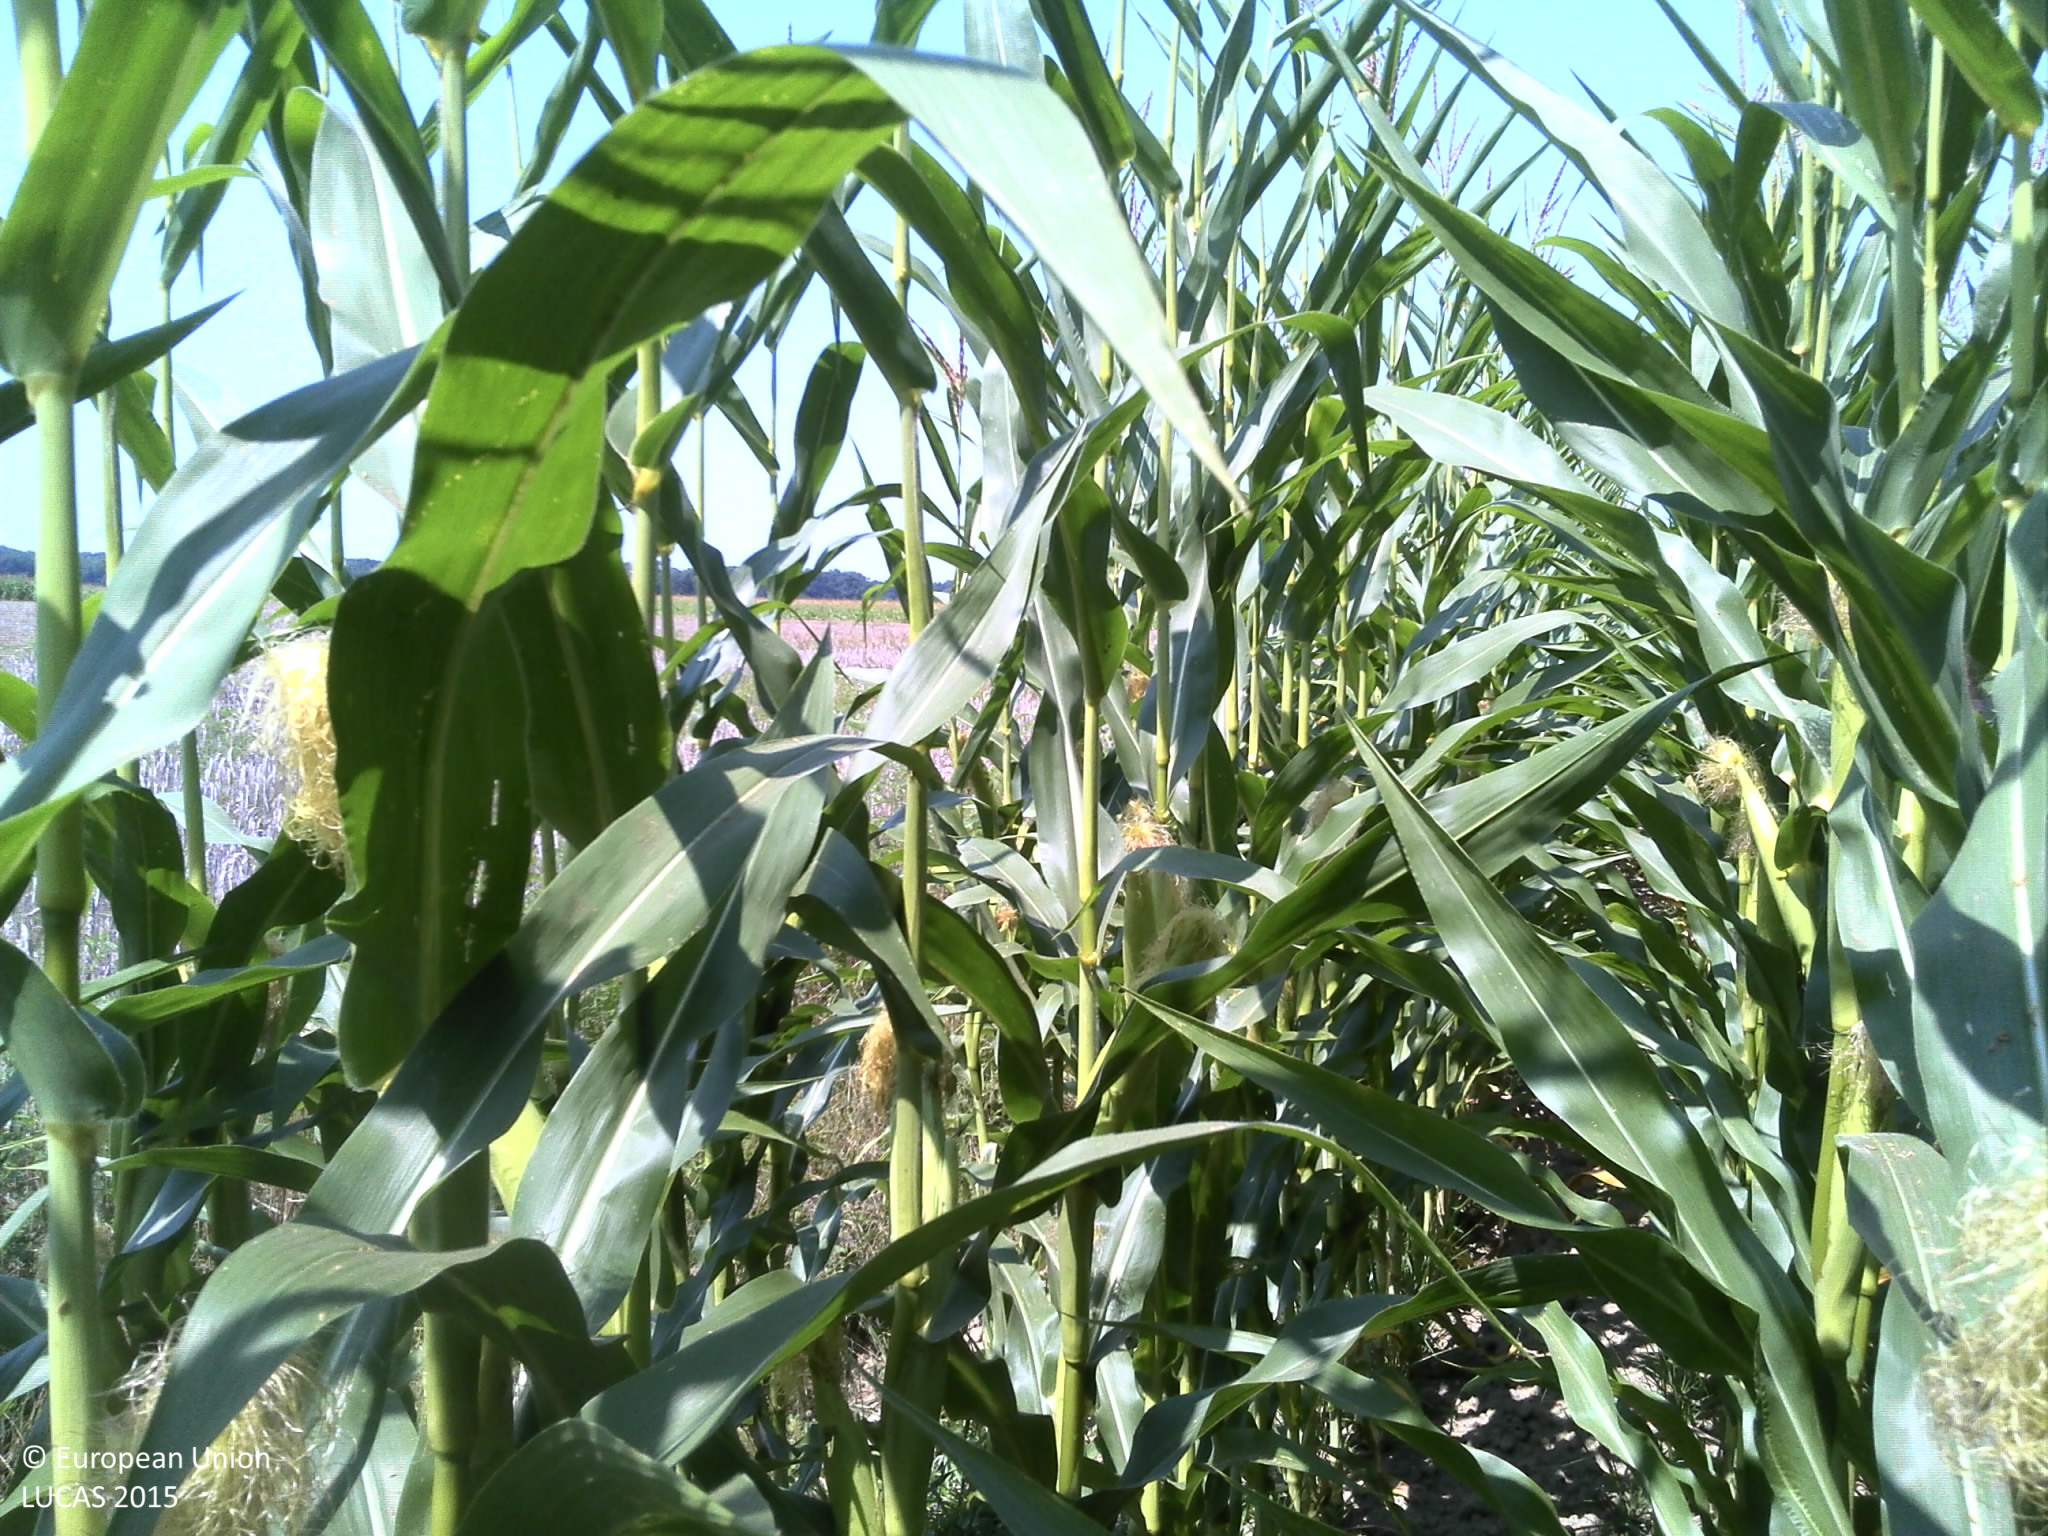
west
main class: Cropland
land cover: Maize
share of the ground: > 75 %
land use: Agriculture (excluding fallow land and kitchen gardens)
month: July
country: HR
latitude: 45.8660
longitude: 16.7628
